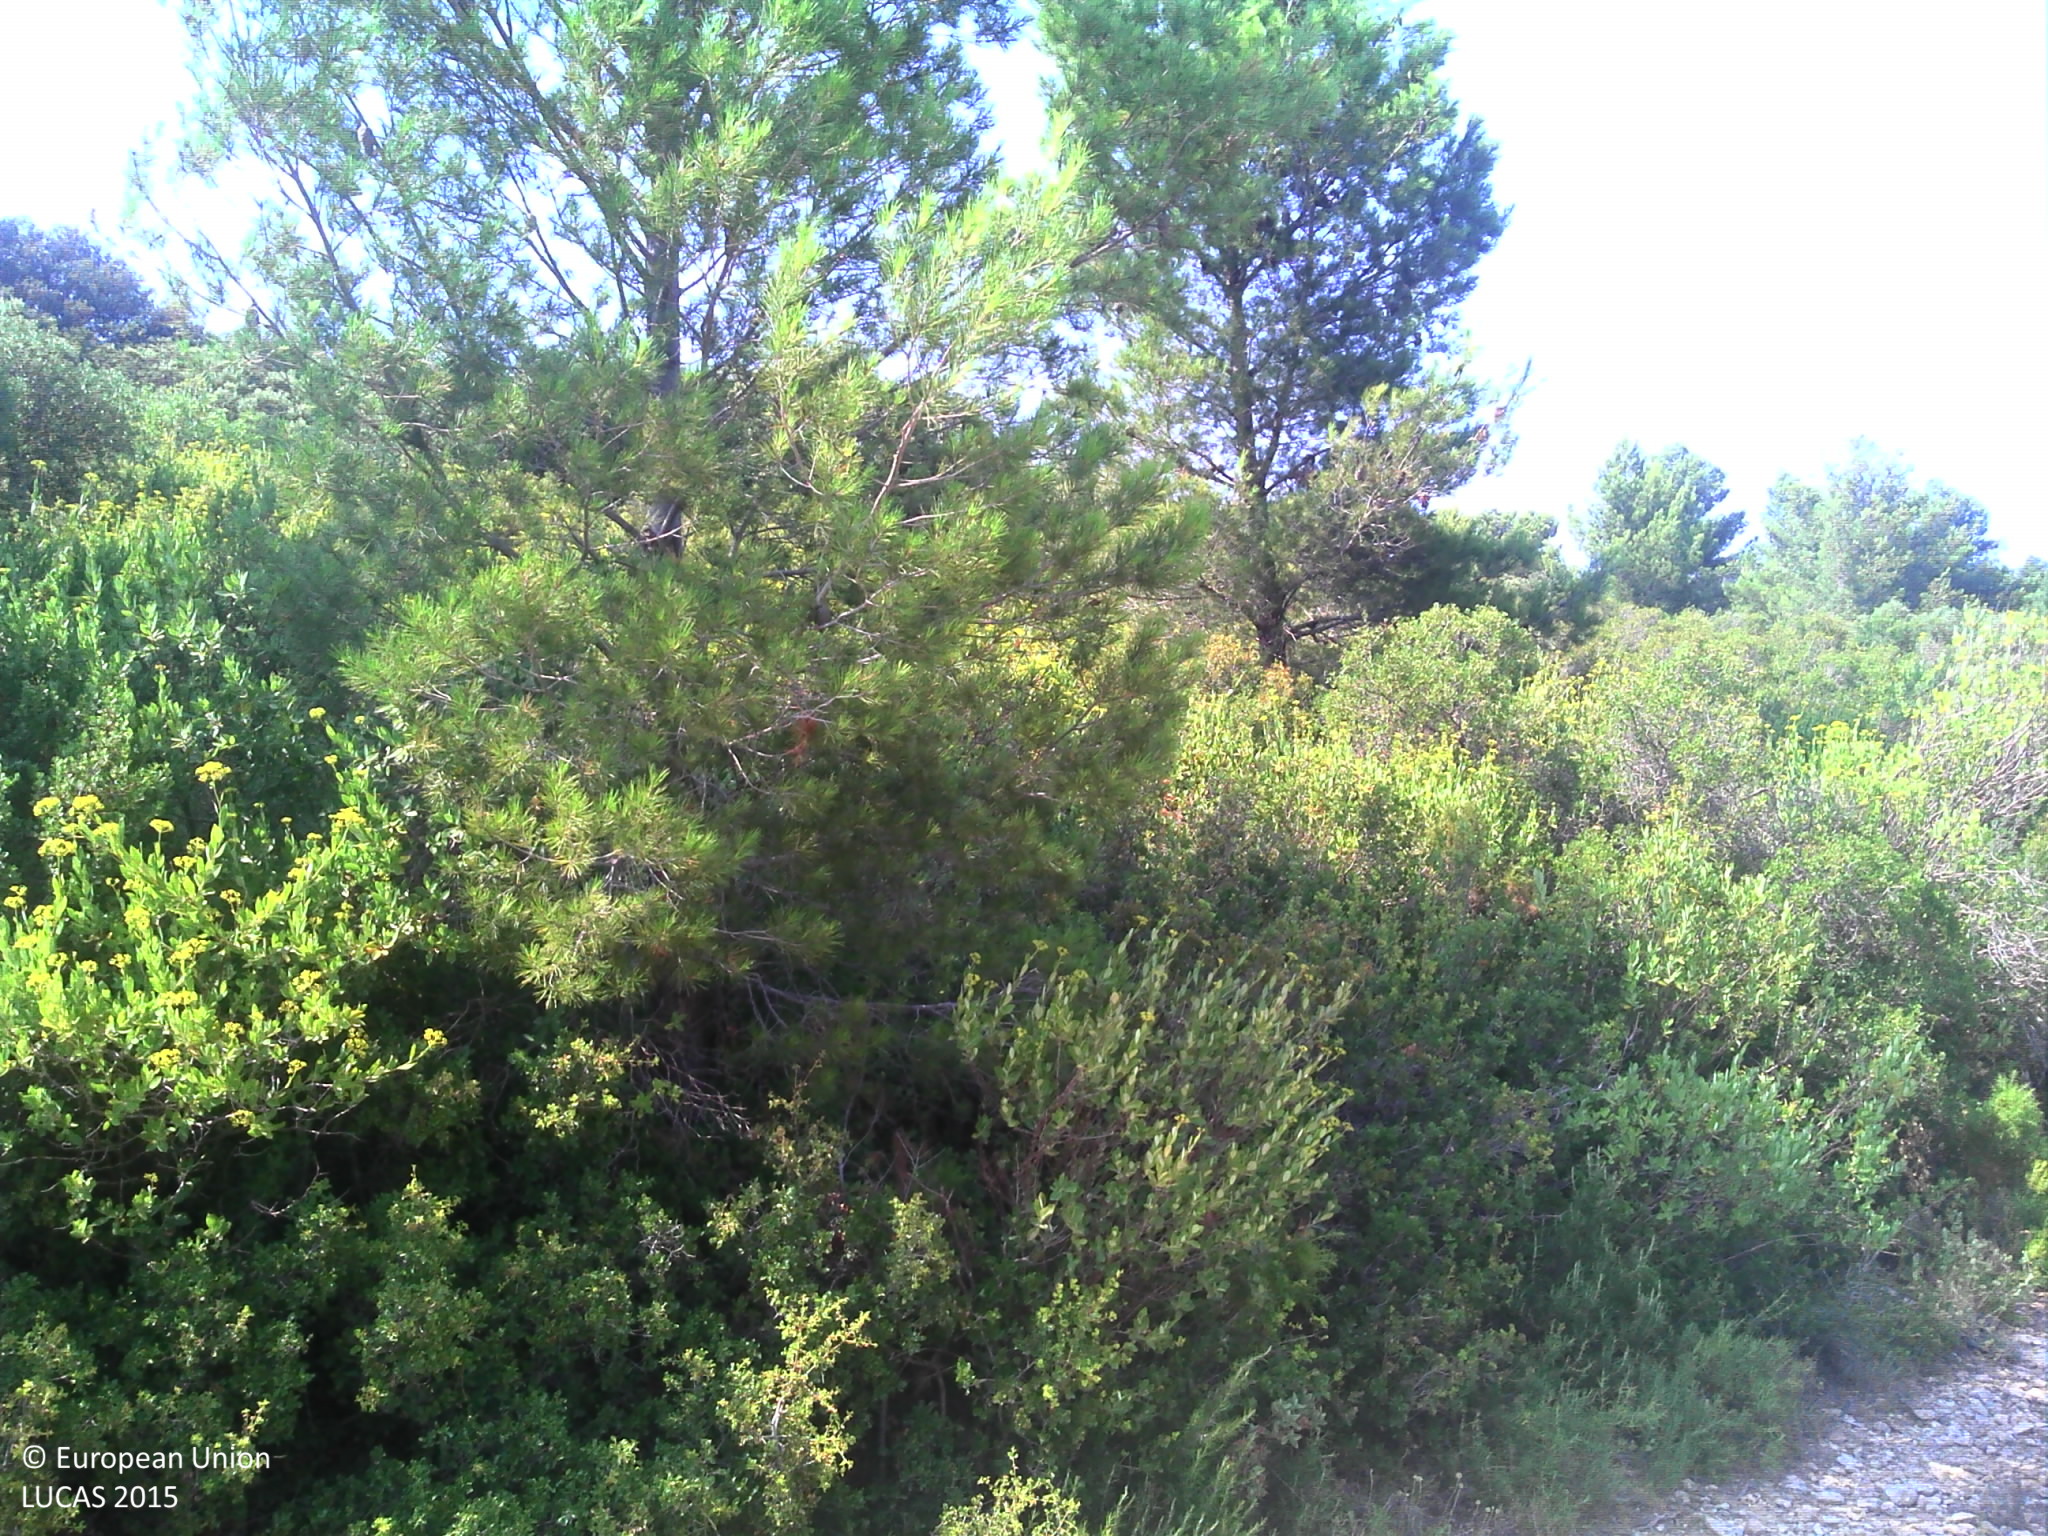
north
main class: Shrubland
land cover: Shrubland without tree cover
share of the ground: > 75 %
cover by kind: shrubs 75 %, herbaceous plants 25 %
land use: Semi-natural and natural areas not in use
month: July
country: FR
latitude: 43.7468
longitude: 4.7315
